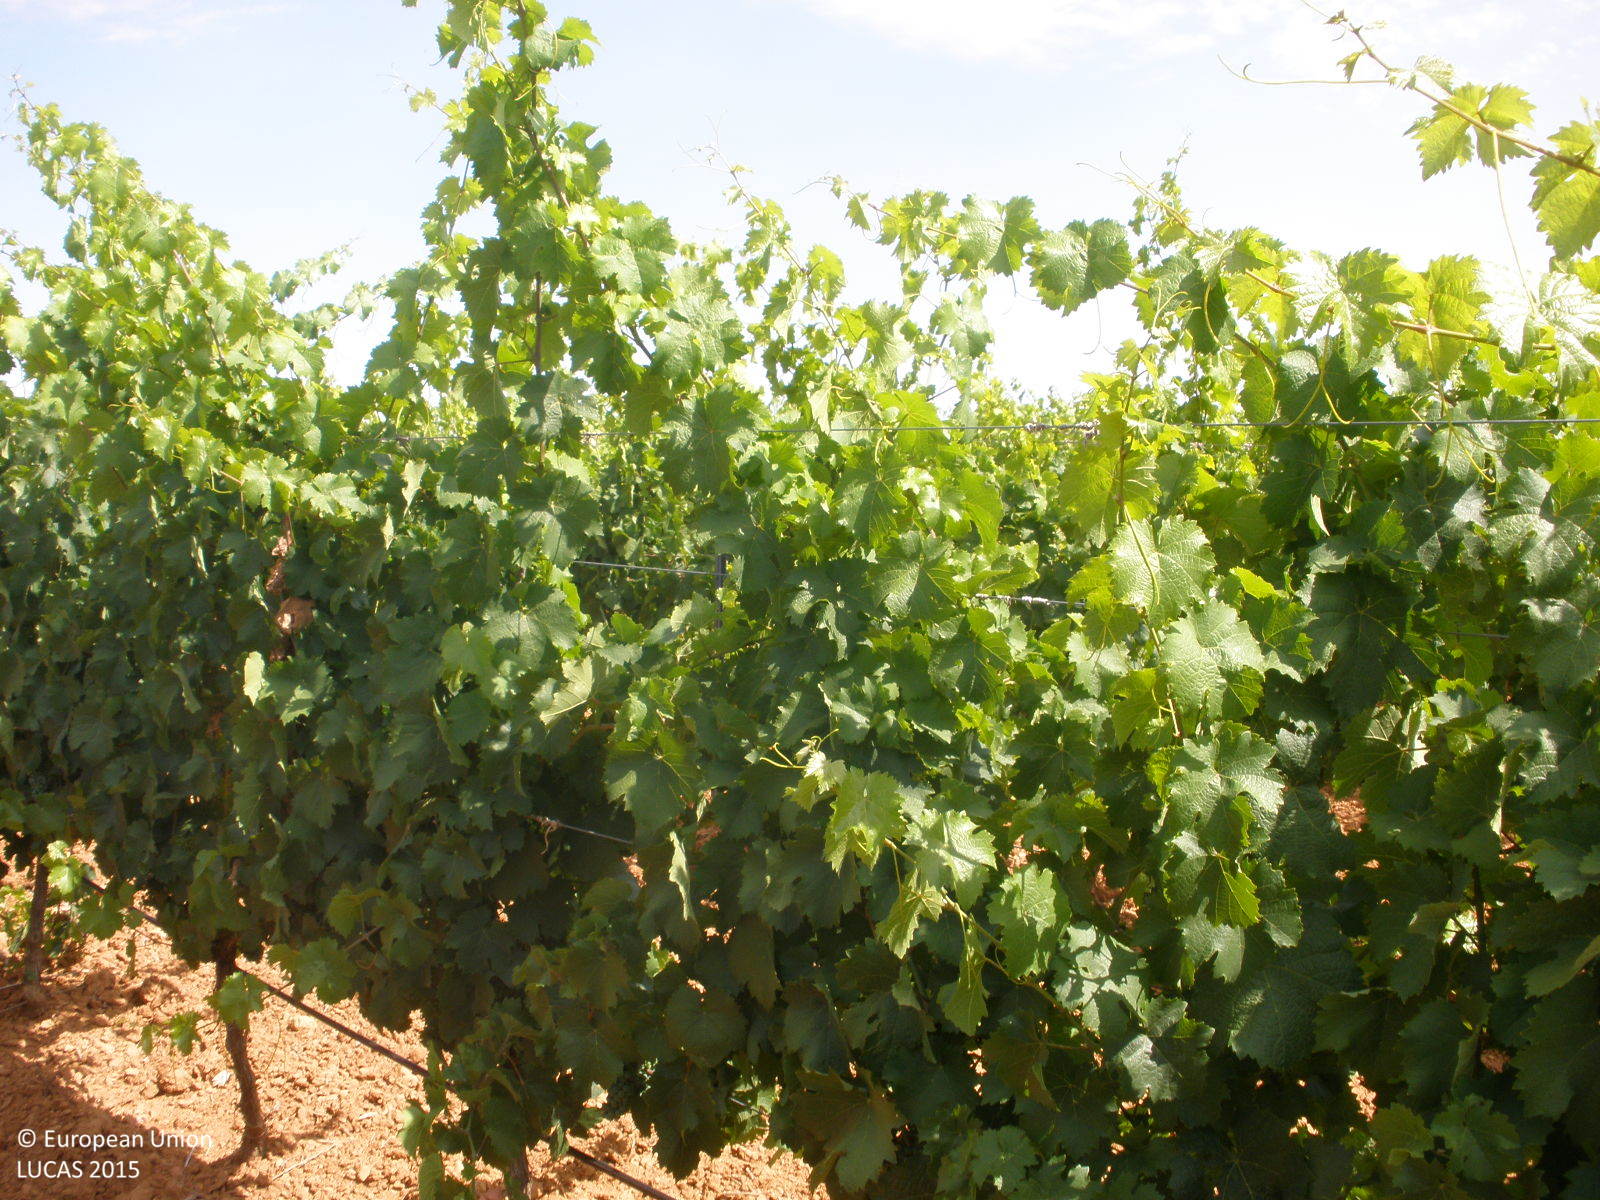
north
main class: Cropland
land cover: Vineyards
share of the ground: 50 - 75 %
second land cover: Other bare soil
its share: > 75 %
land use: Agriculture (excluding fallow land and kitchen gardens)
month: July
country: ES
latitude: 39.8362
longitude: -3.1458
